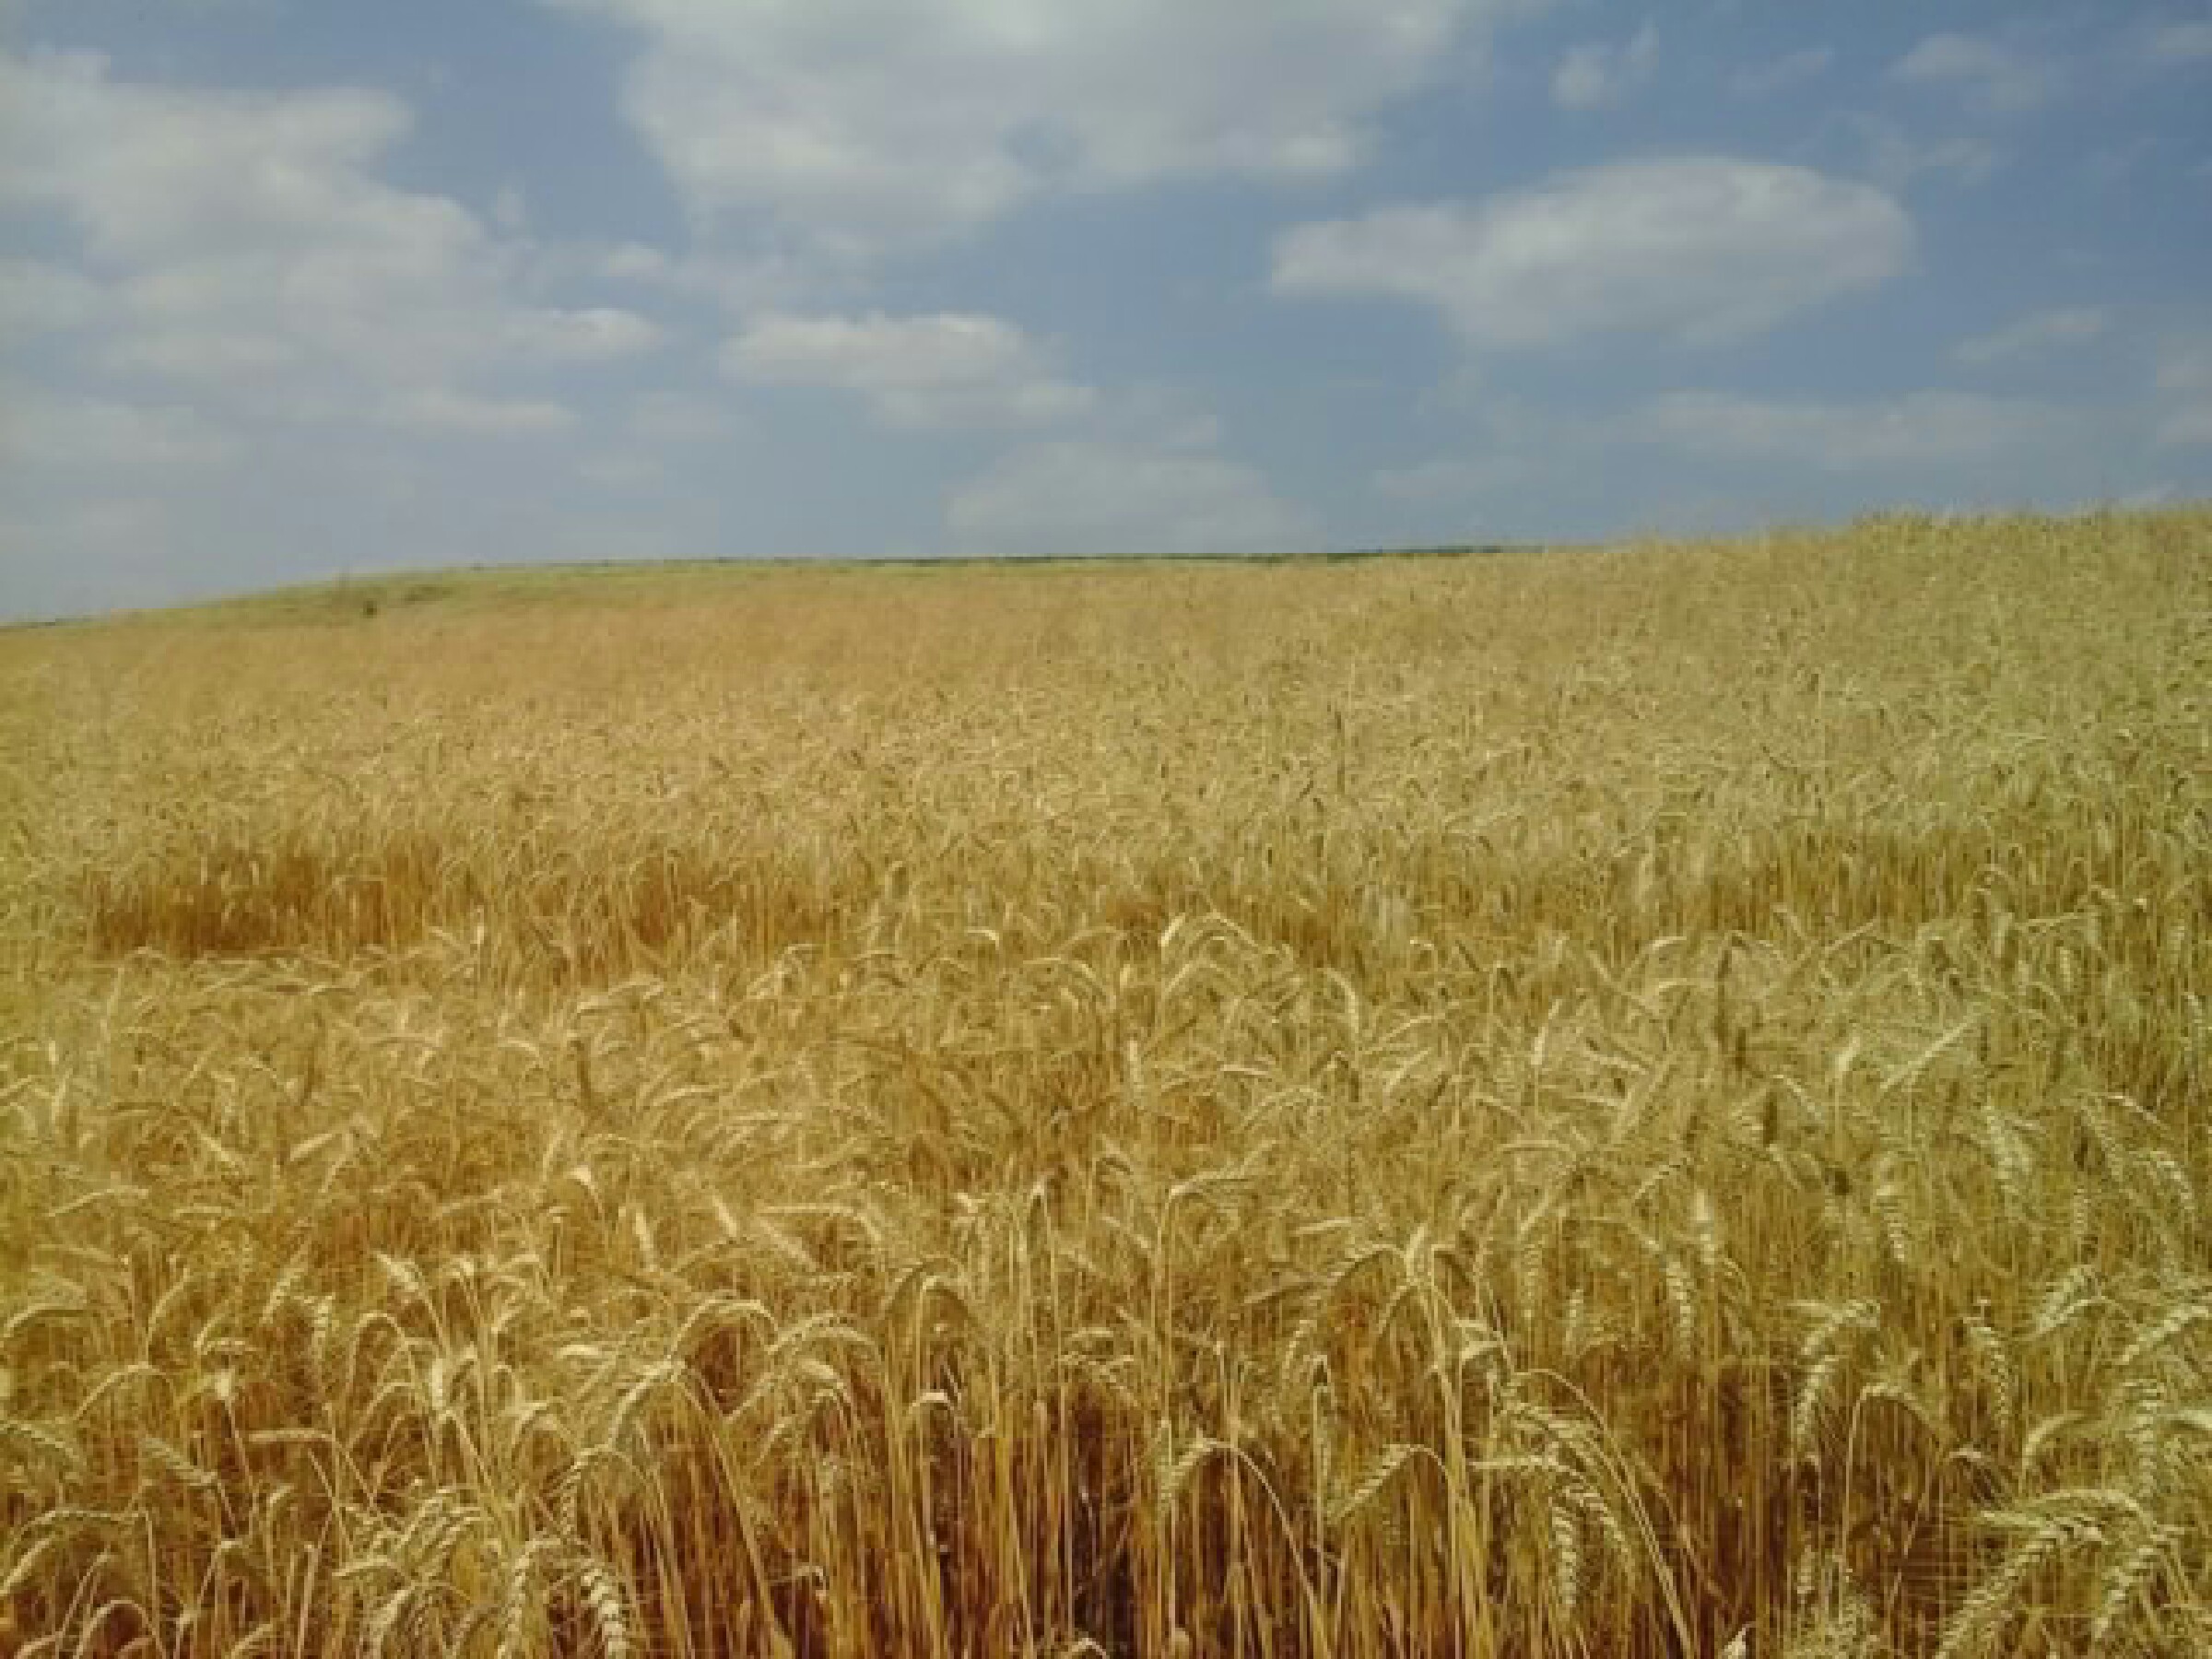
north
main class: Cropland
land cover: Common wheat
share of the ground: > 75 %
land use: Agriculture (excluding fallow land and kitchen gardens)
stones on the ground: < 10 %
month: July
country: HU
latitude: 47.8581
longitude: 19.3915
